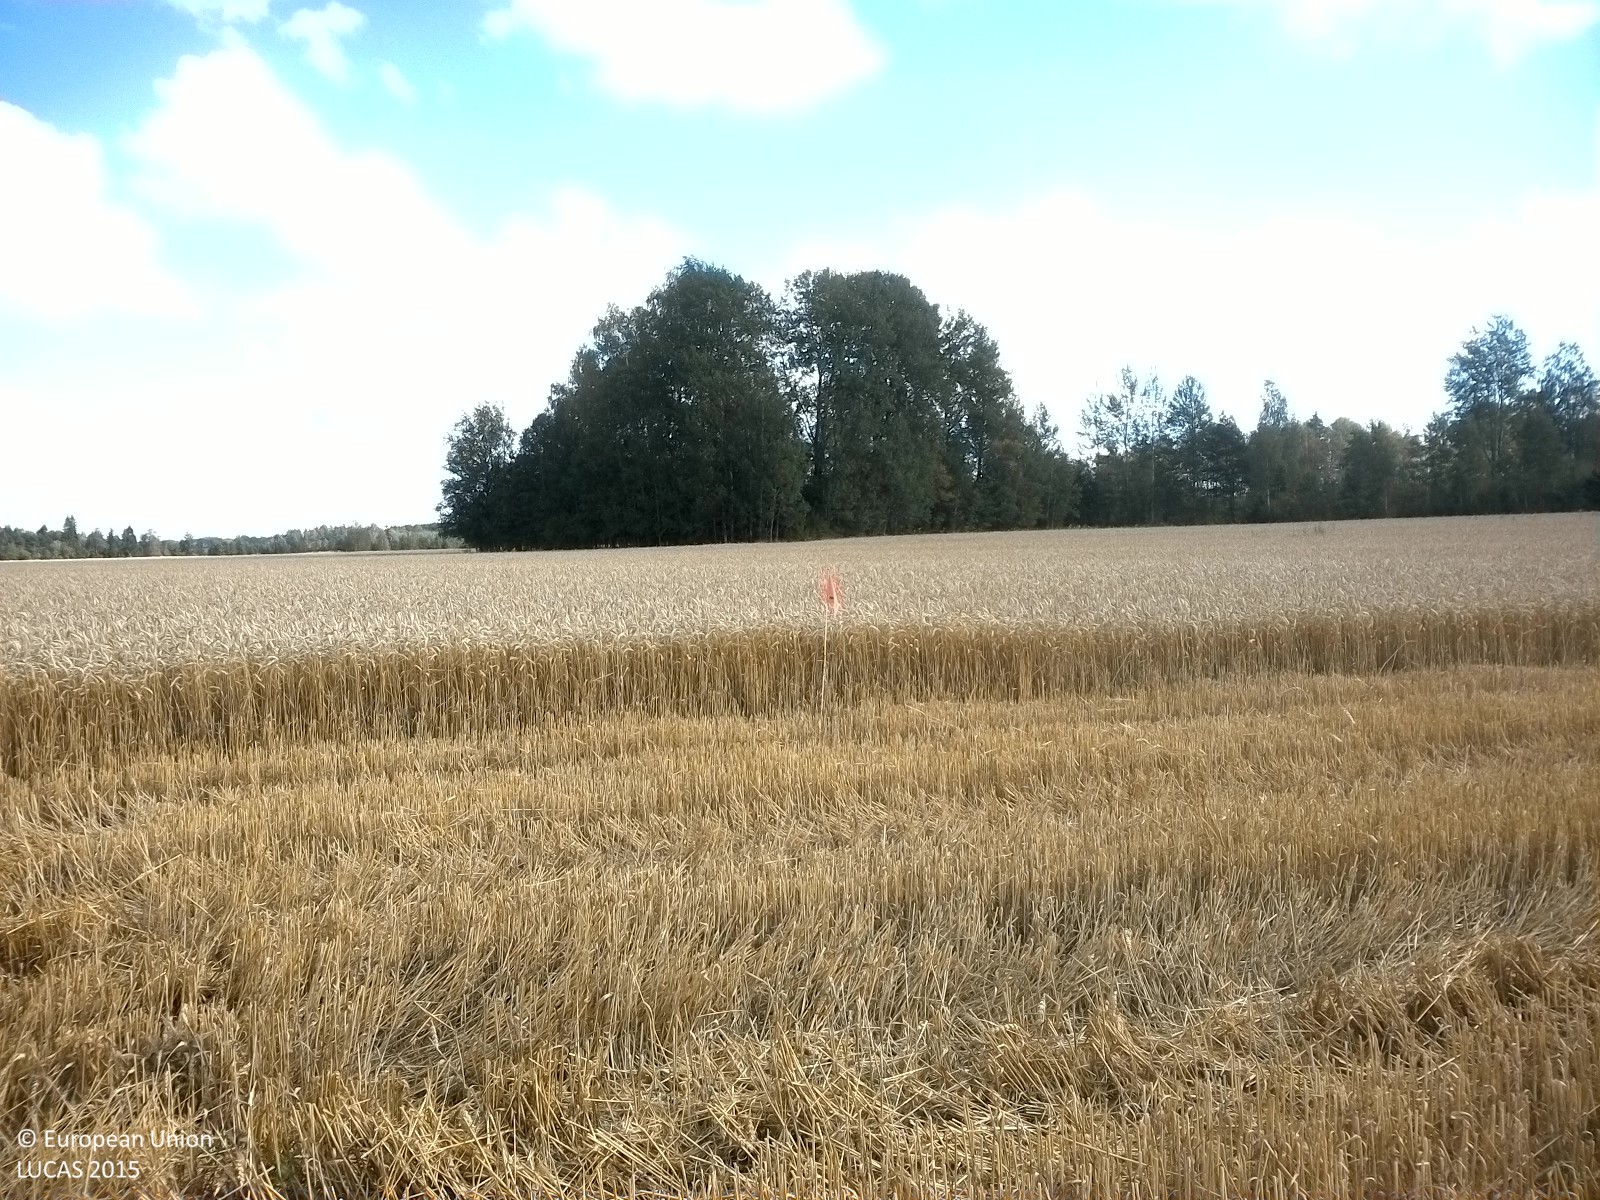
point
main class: Cropland
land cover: Common wheat
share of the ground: > 75 %
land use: Agriculture (excluding fallow land and kitchen gardens)
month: August
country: SE
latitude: 59.4370
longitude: 15.1571
